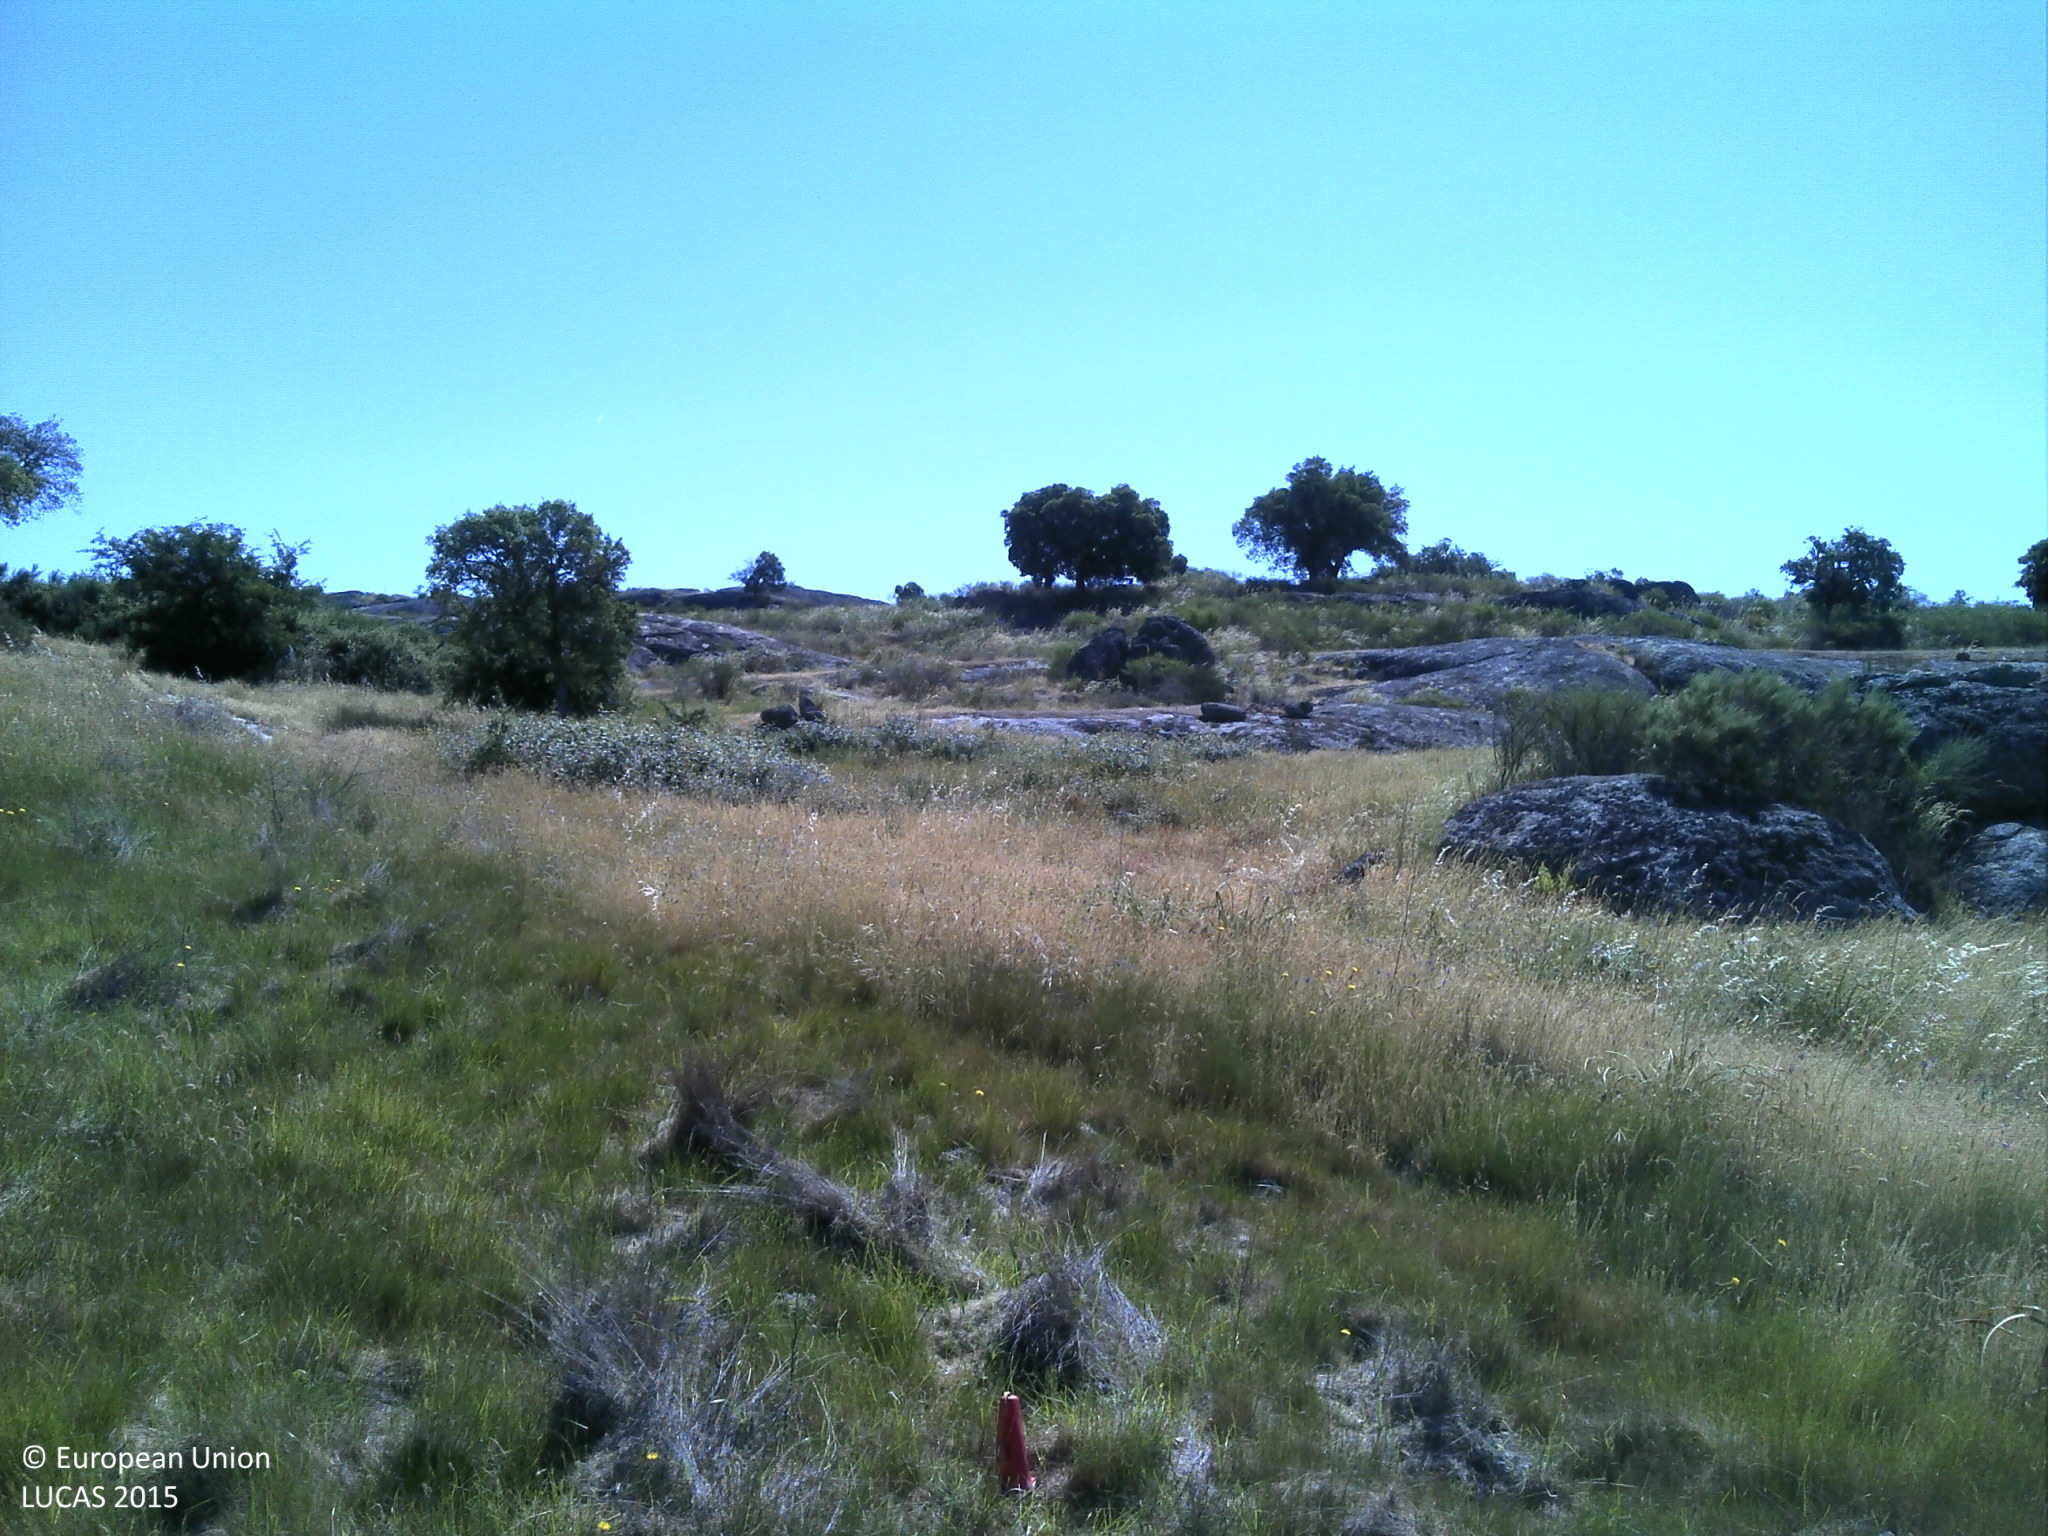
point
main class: Grassland
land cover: Grassland without tree/shrub cover
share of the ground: 25 - 50 %
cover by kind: herbaceous plants 55 %, unconsolidated bare surface 40 %, shrubs 5 %
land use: Agriculture (excluding fallow land and kitchen gardens)
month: May
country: PT
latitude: 39.4855
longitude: -7.6409
